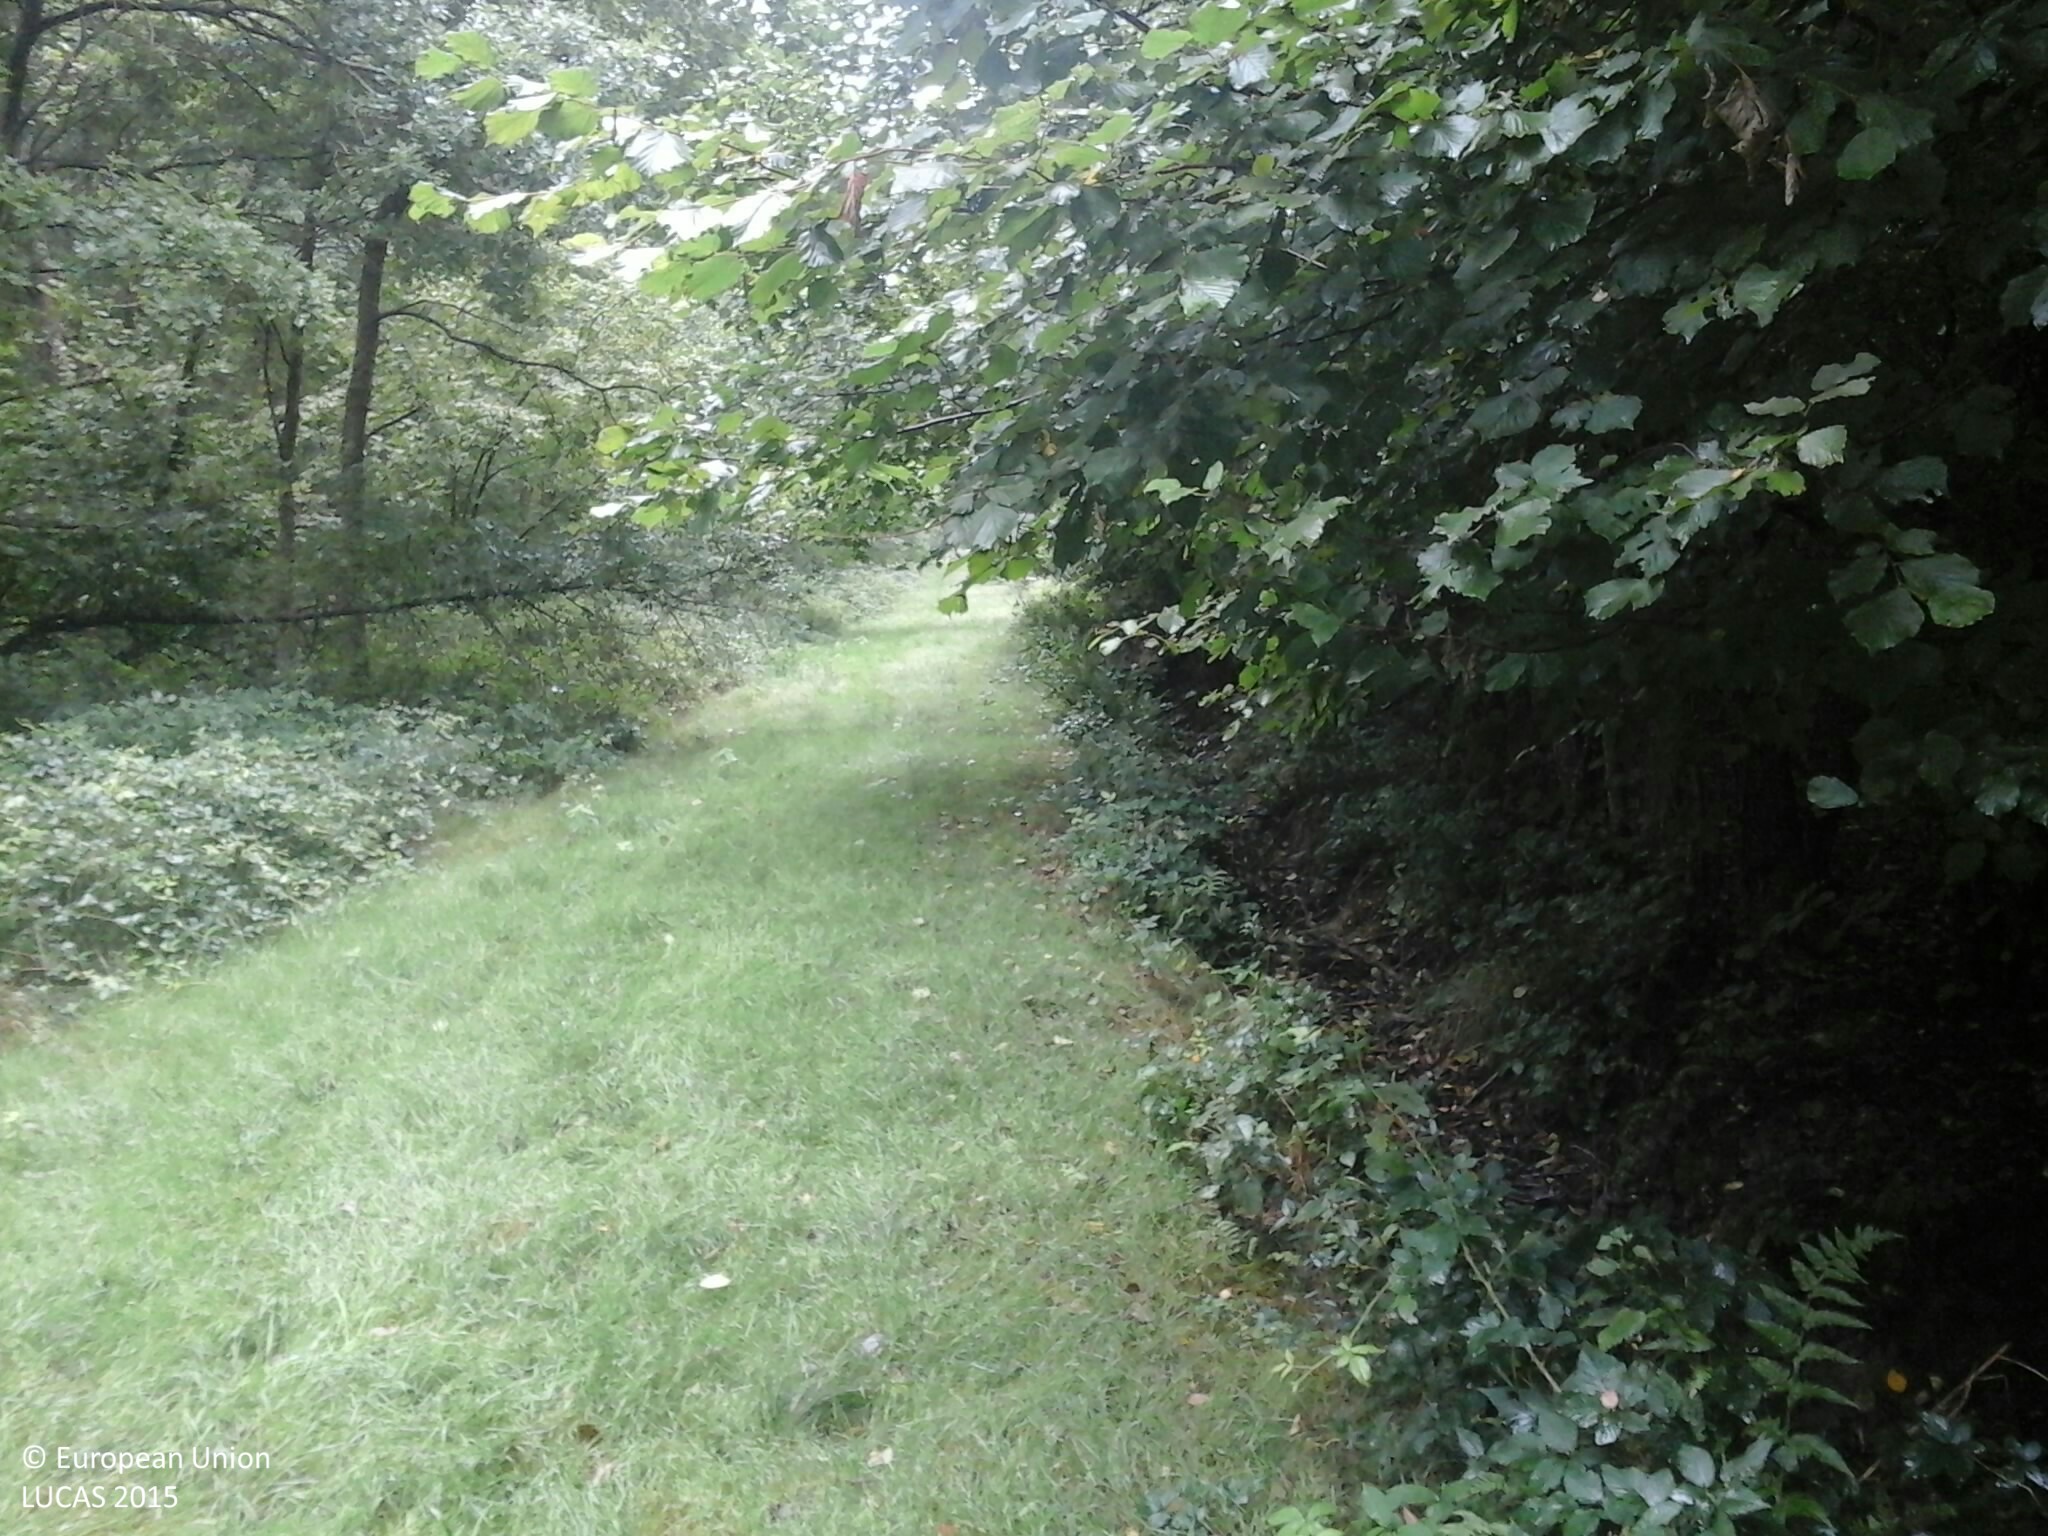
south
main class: Woodland
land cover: Broadleaved woodland
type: mesophytic deciduous forest
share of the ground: > 75 %
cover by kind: broadleaved forest trees 75 %, herbaceous plants 15 %, shrubs 10 %
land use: Forestry
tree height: > 5 m
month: July
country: HU
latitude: 46.9121
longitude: 16.5015
